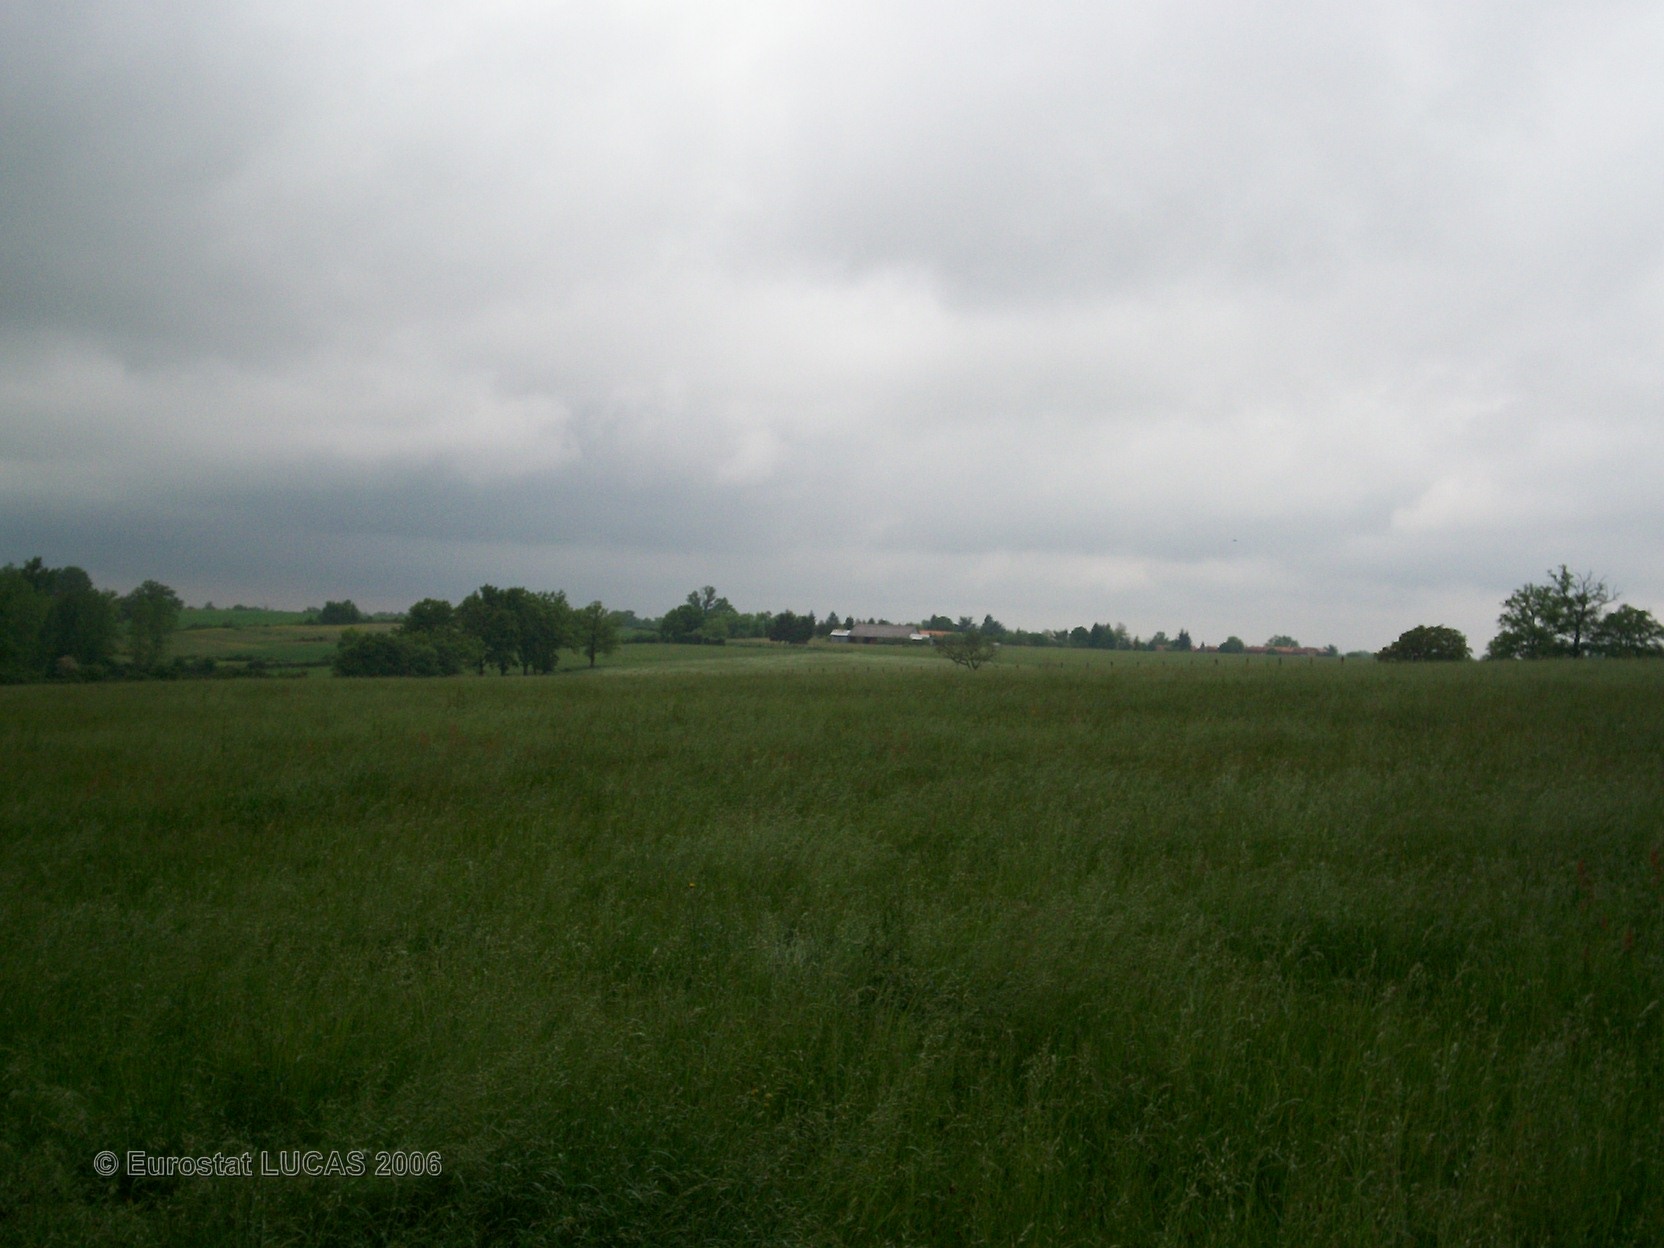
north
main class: Grassland
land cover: Grassland without tree/shrub cover
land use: Agriculture (excluding fallow land and kitchen gardens)
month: May
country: FR
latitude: 45.7807
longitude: 0.4808
